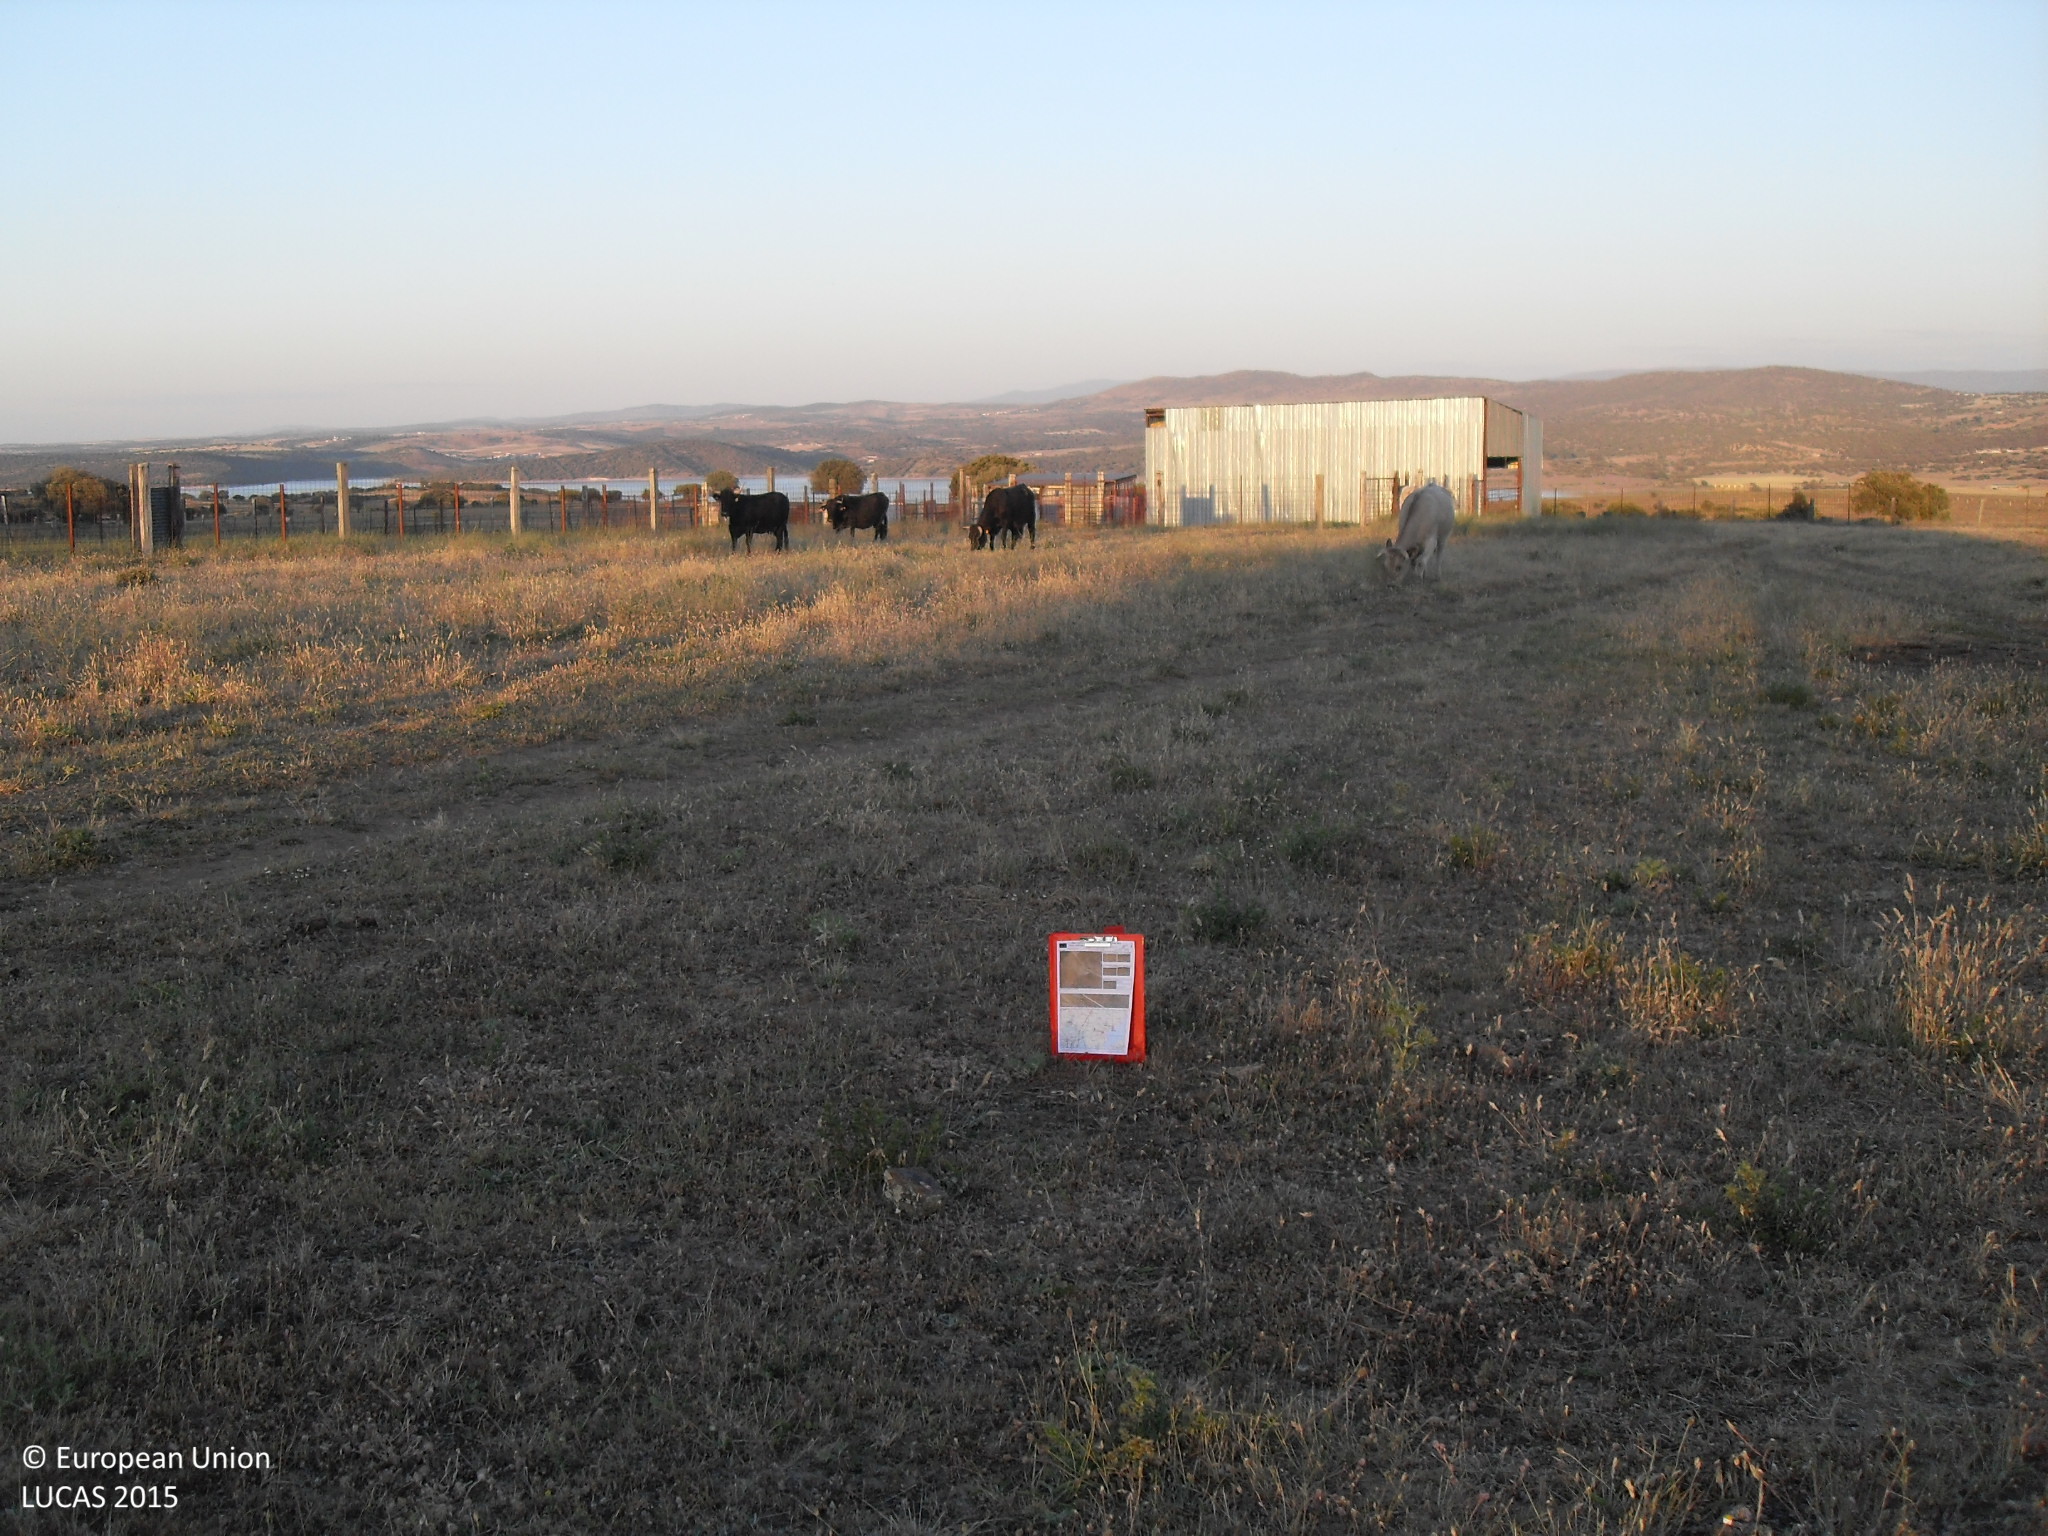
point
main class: Grassland
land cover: Grassland without tree/shrub cover
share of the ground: > 75 %
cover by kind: herbaceous plants 100 %
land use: Agriculture (excluding fallow land and kitchen gardens)
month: June
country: ES
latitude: 40.5867
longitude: -5.6314
